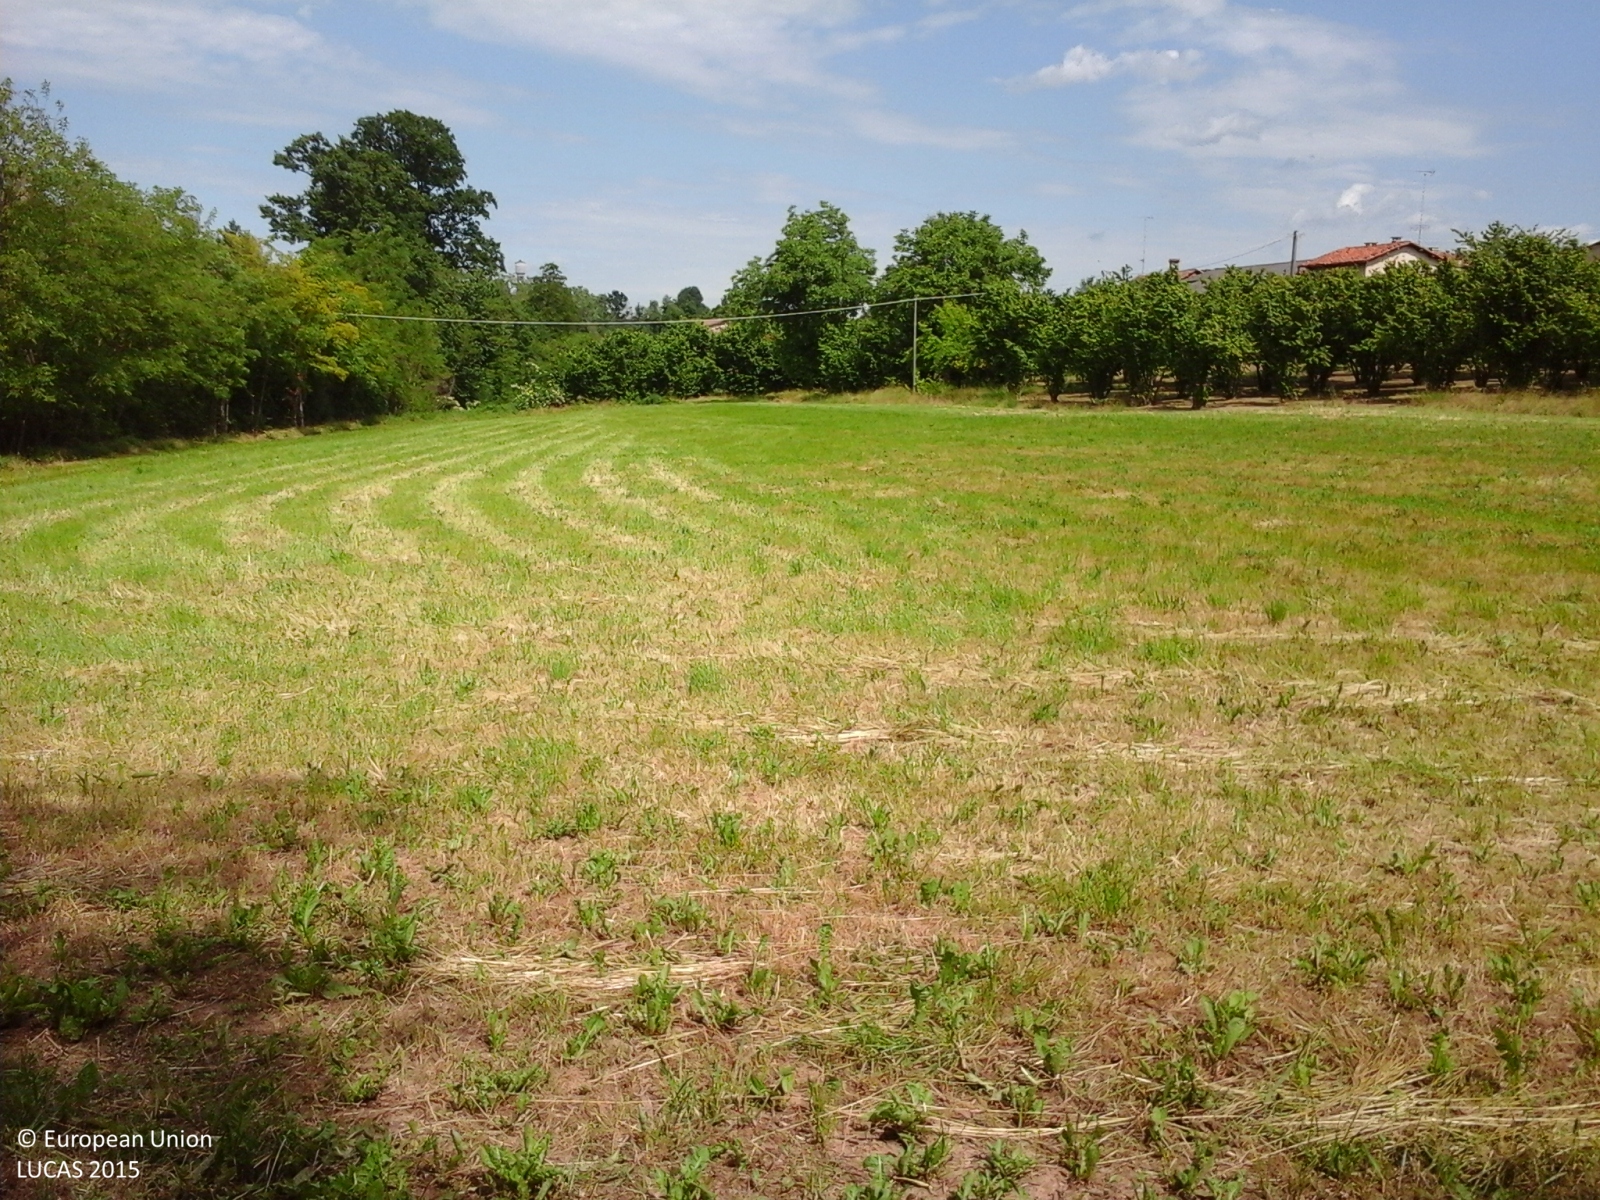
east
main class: Woodland
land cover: Broadleaved woodland
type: thermophilous deciduous forest
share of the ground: > 75 %
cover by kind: broadleaved forest trees 100 %
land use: Semi-natural and natural areas not in use
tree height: > 5 m
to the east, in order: Broadleaved woodland; Temporary grasslands; Electric lines; Temporary grasslands; Grassland without tree/shrub cover; Tracks; Nuts trees; Fences; Other fresh vegetables; Fences; Nuts trees; Electric lines; Nuts trees
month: May
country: IT
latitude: 44.4722
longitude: 7.8298
